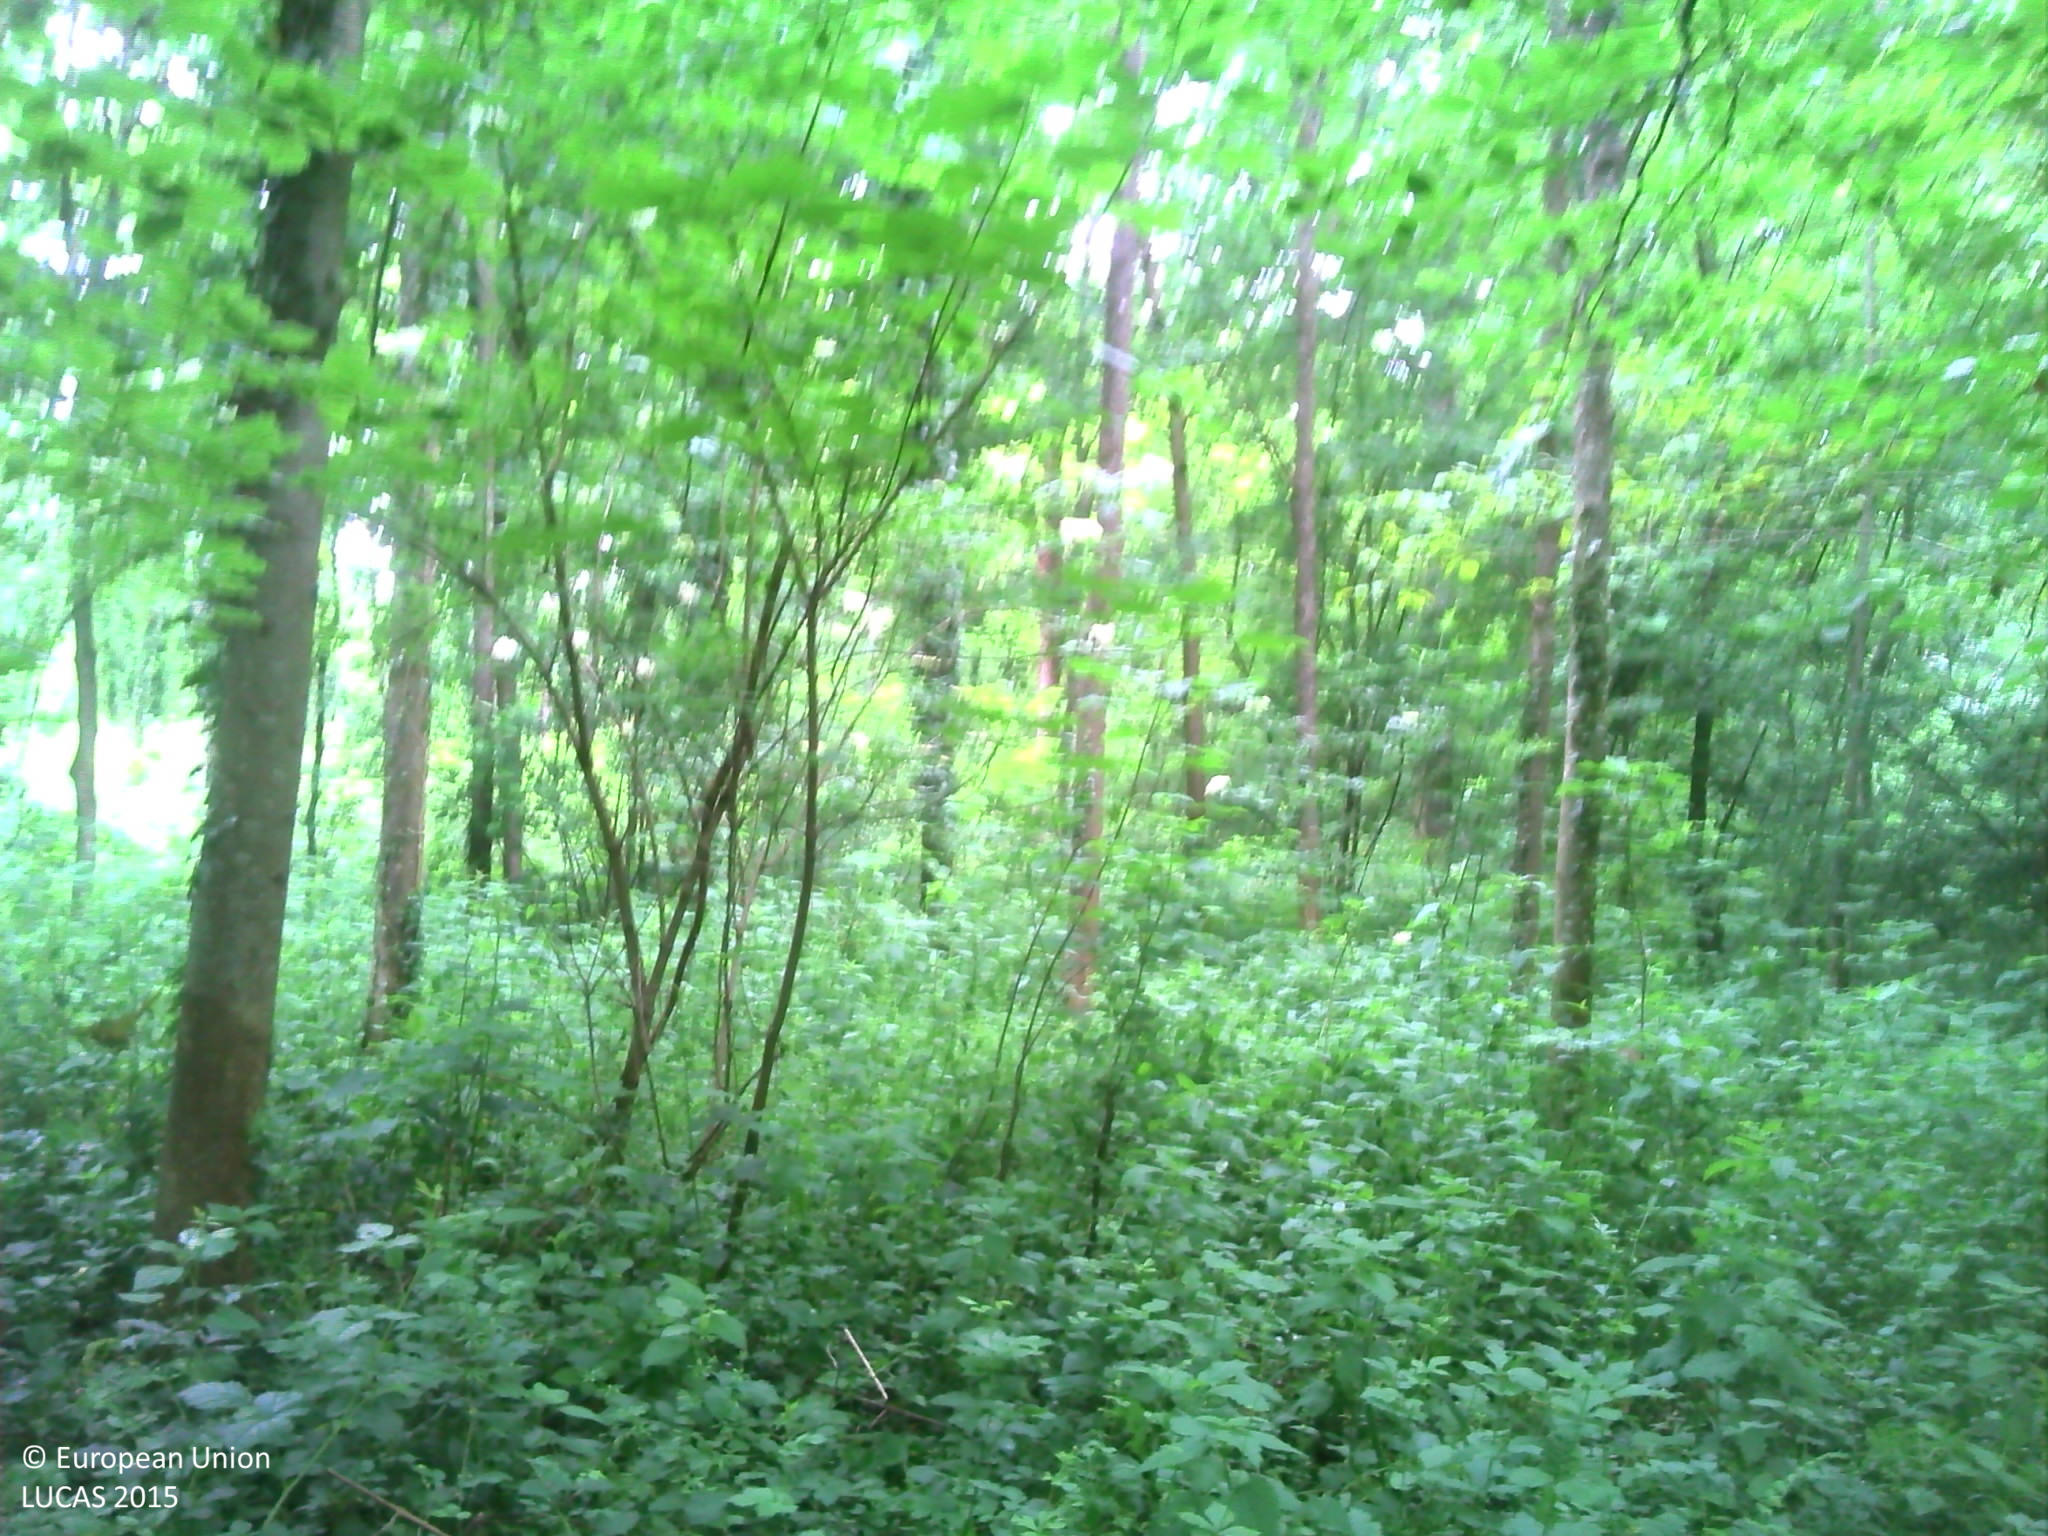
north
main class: Woodland
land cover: Broadleaved woodland
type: mesophytic deciduous forest
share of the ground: > 75 %
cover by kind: broadleaved forest trees 90 %, herbaceous plants 10 %
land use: Forestry
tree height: > 5 m
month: May
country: FR
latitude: 48.3064
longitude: 7.6416
